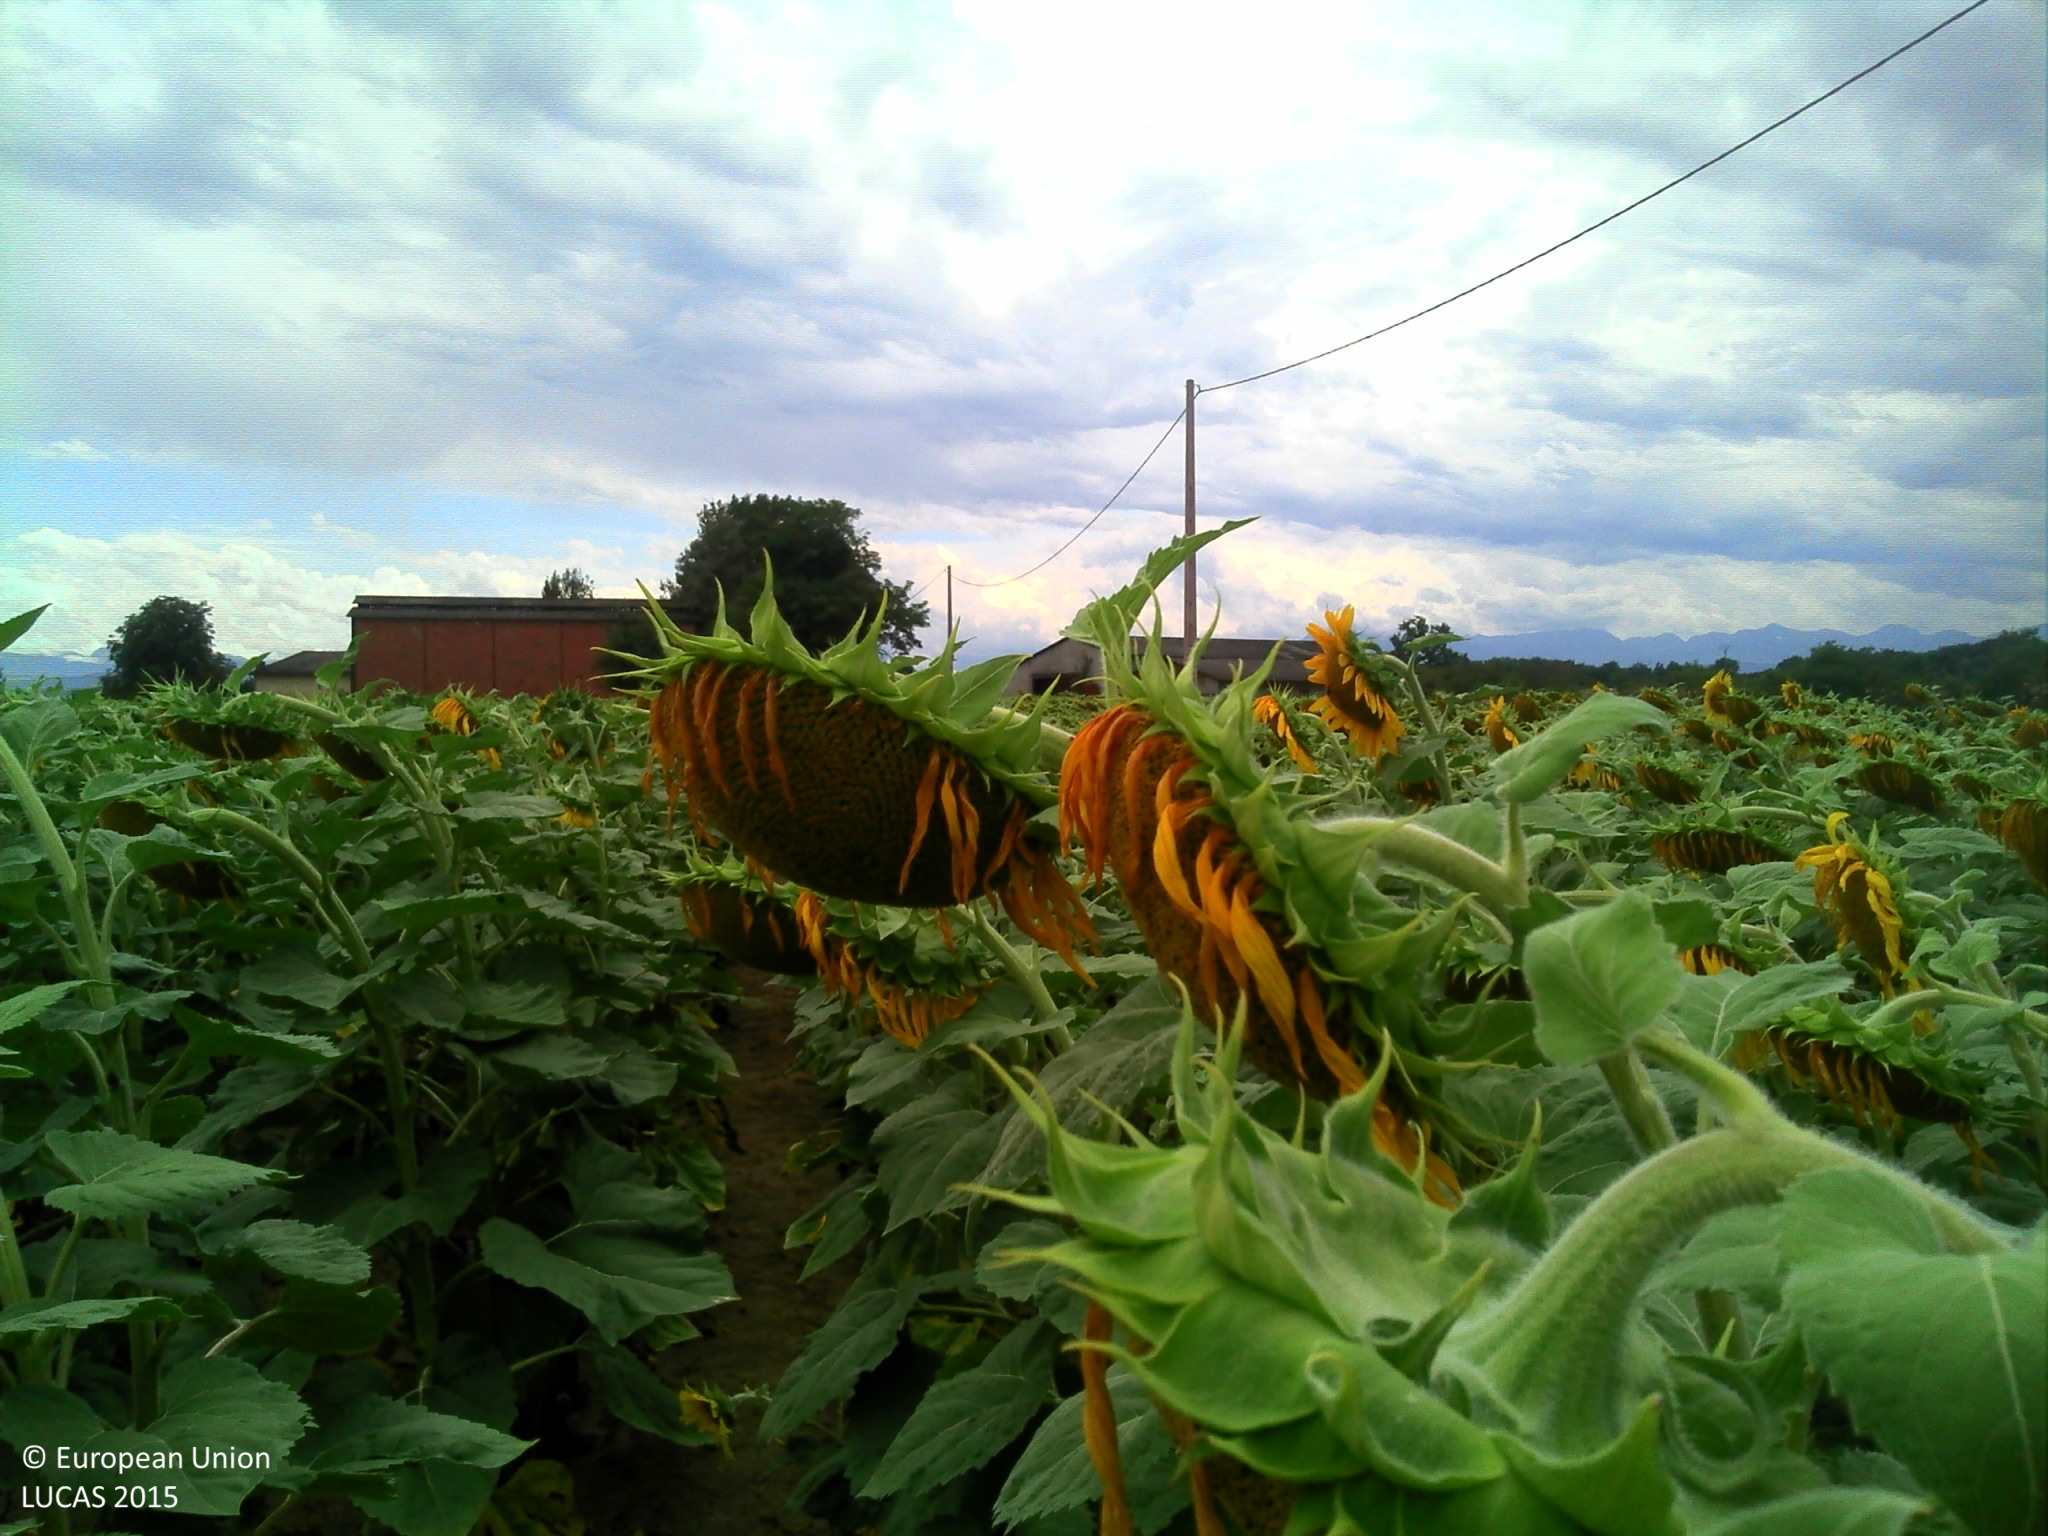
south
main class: Cropland
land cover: Sunflower
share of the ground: > 75 %
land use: Agriculture (excluding fallow land and kitchen gardens)
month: July
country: FR
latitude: 43.2302
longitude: 1.1752
